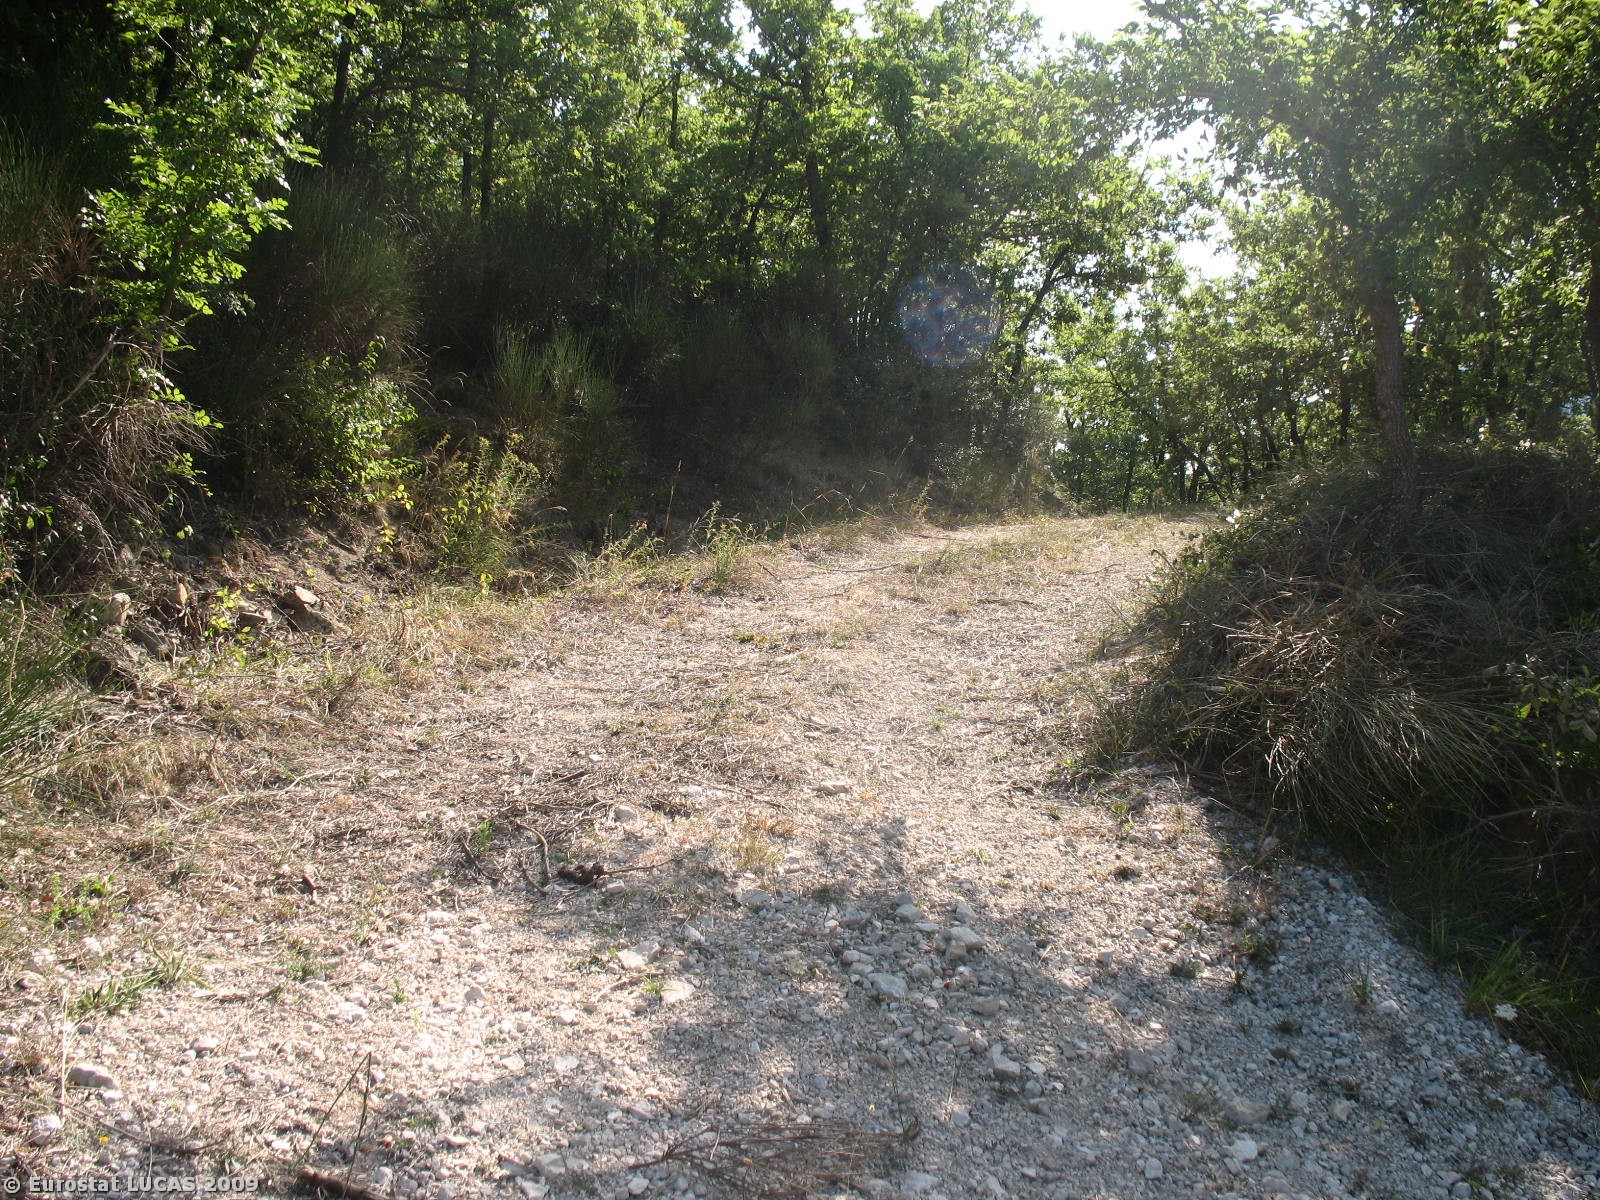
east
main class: Woodland
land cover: Broadleaved woodland
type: mesophytic deciduous forest
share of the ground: > 75 %
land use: Agriculture (excluding fallow land and kitchen gardens)
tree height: > 5 m
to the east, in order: Broadleaved woodland; Tracks; Broadleaved woodland; Paved roads, cycling and walking lanes; Fences; Abandoned hedges; Tracks; Abandoned hedges; Grassland with sparse tree/shrub cover; Broadleaved woodland
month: July
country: IT
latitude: 40.8613
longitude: 15.0696
